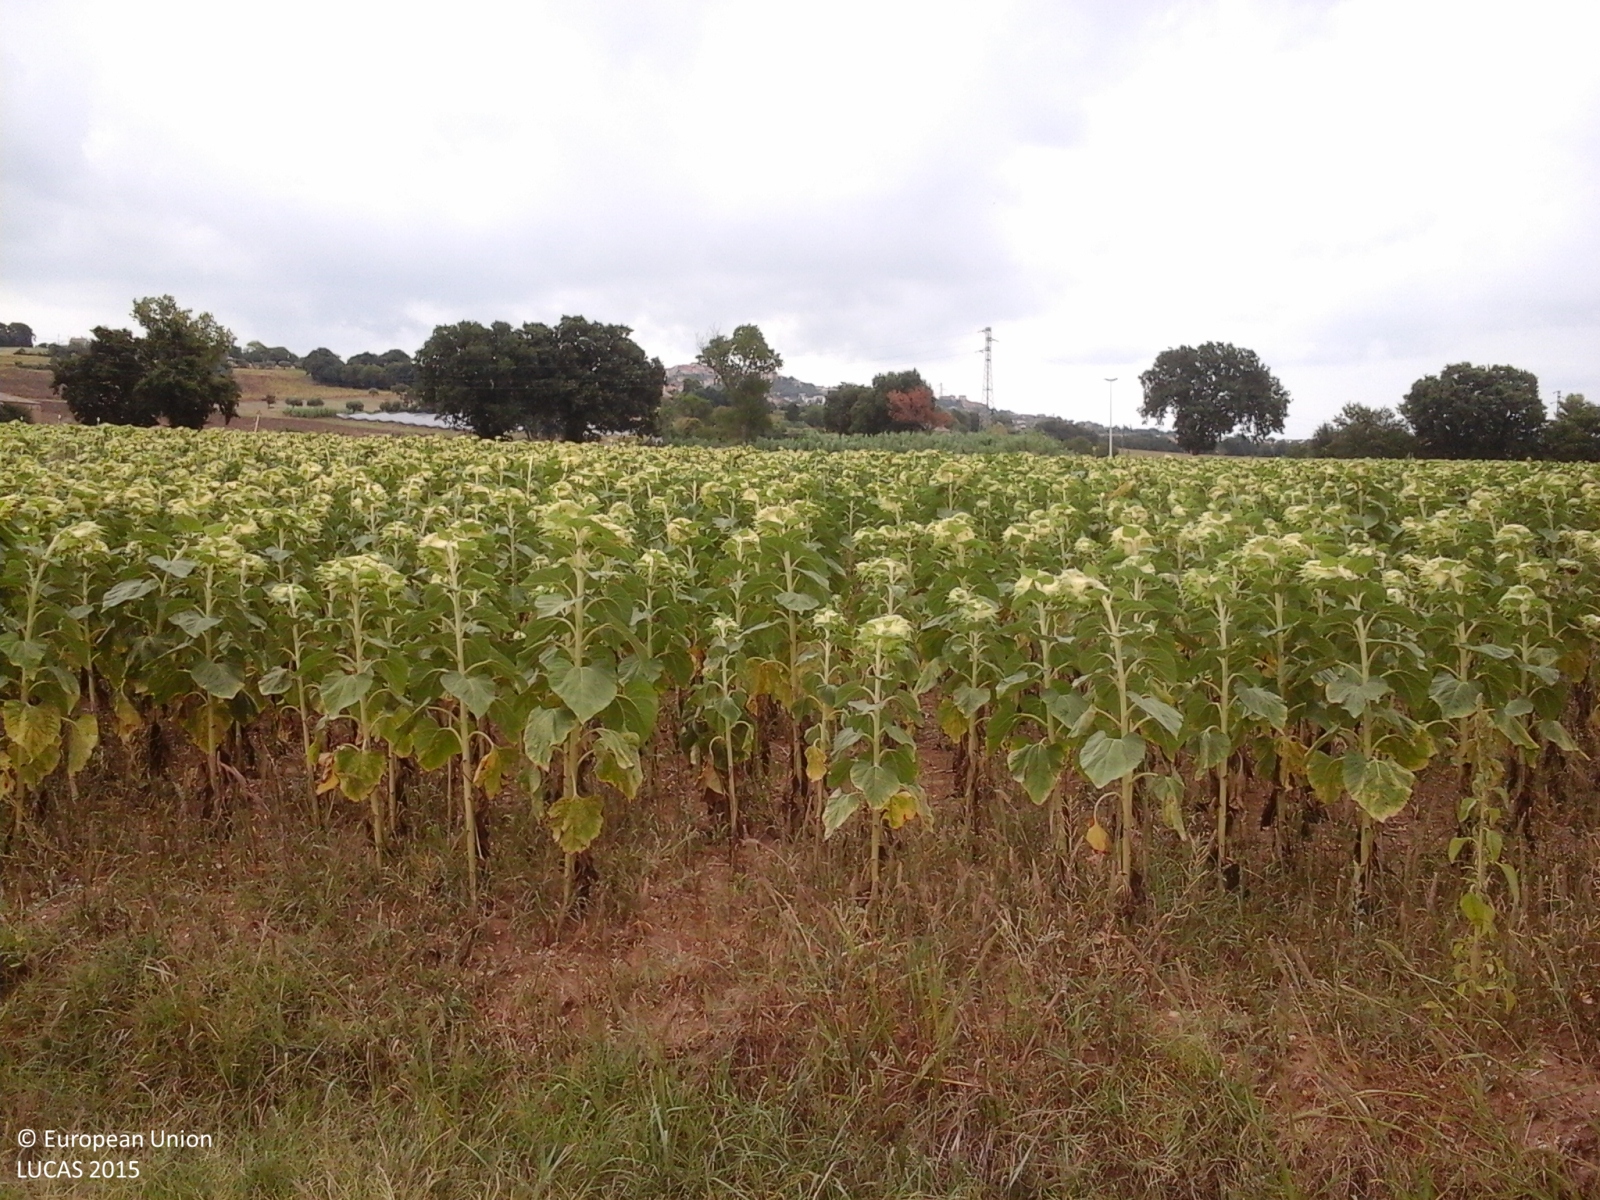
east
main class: Cropland
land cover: Sunflower
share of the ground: > 75 %
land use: Agriculture (excluding fallow land and kitchen gardens)
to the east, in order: Sunflower; Ditches and canals; Paved roads, cycling and walking lanes; Ditches and canals; Sunflower; Ditches and canals; Grass margins; Paved roads, cycling and walking lanes; Grass margins; Ditches and canals; Sunflower
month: August
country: IT
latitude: 43.4604
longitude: 13.5138
